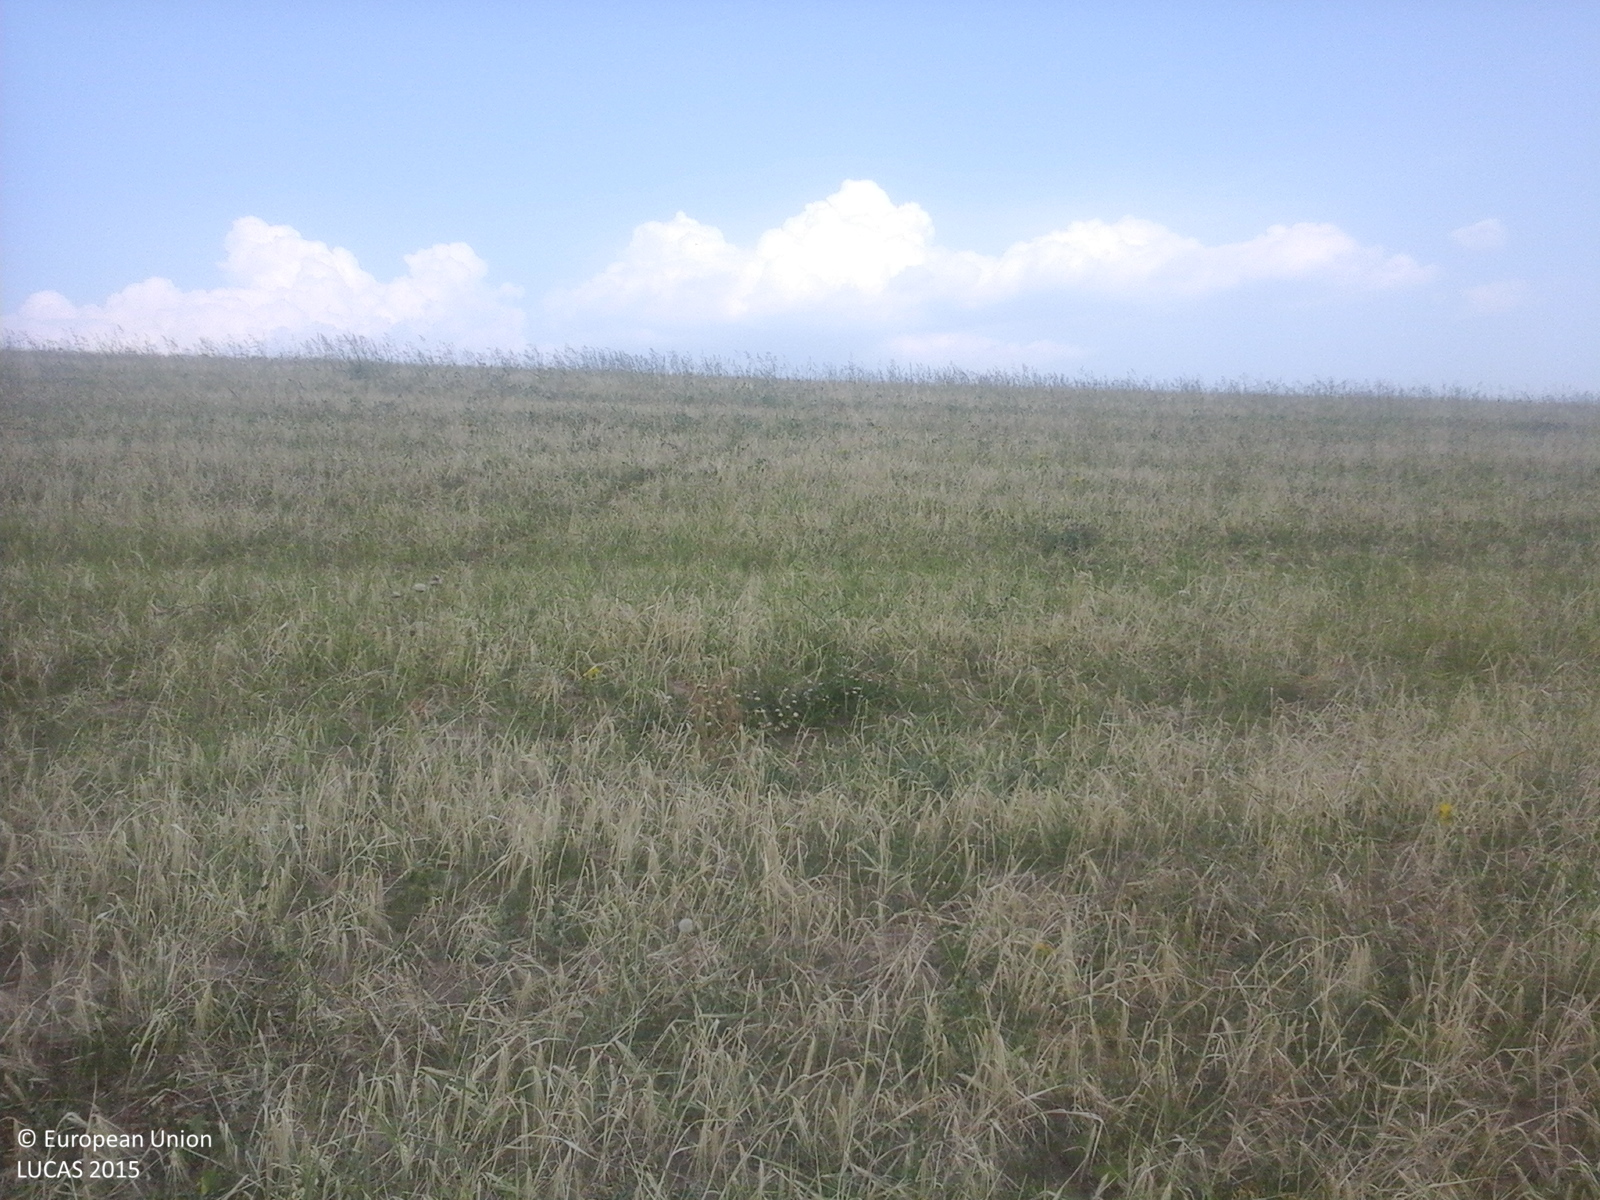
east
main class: Cropland
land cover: Barley
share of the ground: 50 - 75 %
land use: Agriculture (excluding fallow land and kitchen gardens)
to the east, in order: Barley; Common wheat
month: July
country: RO
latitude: 45.8569
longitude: 28.0106
